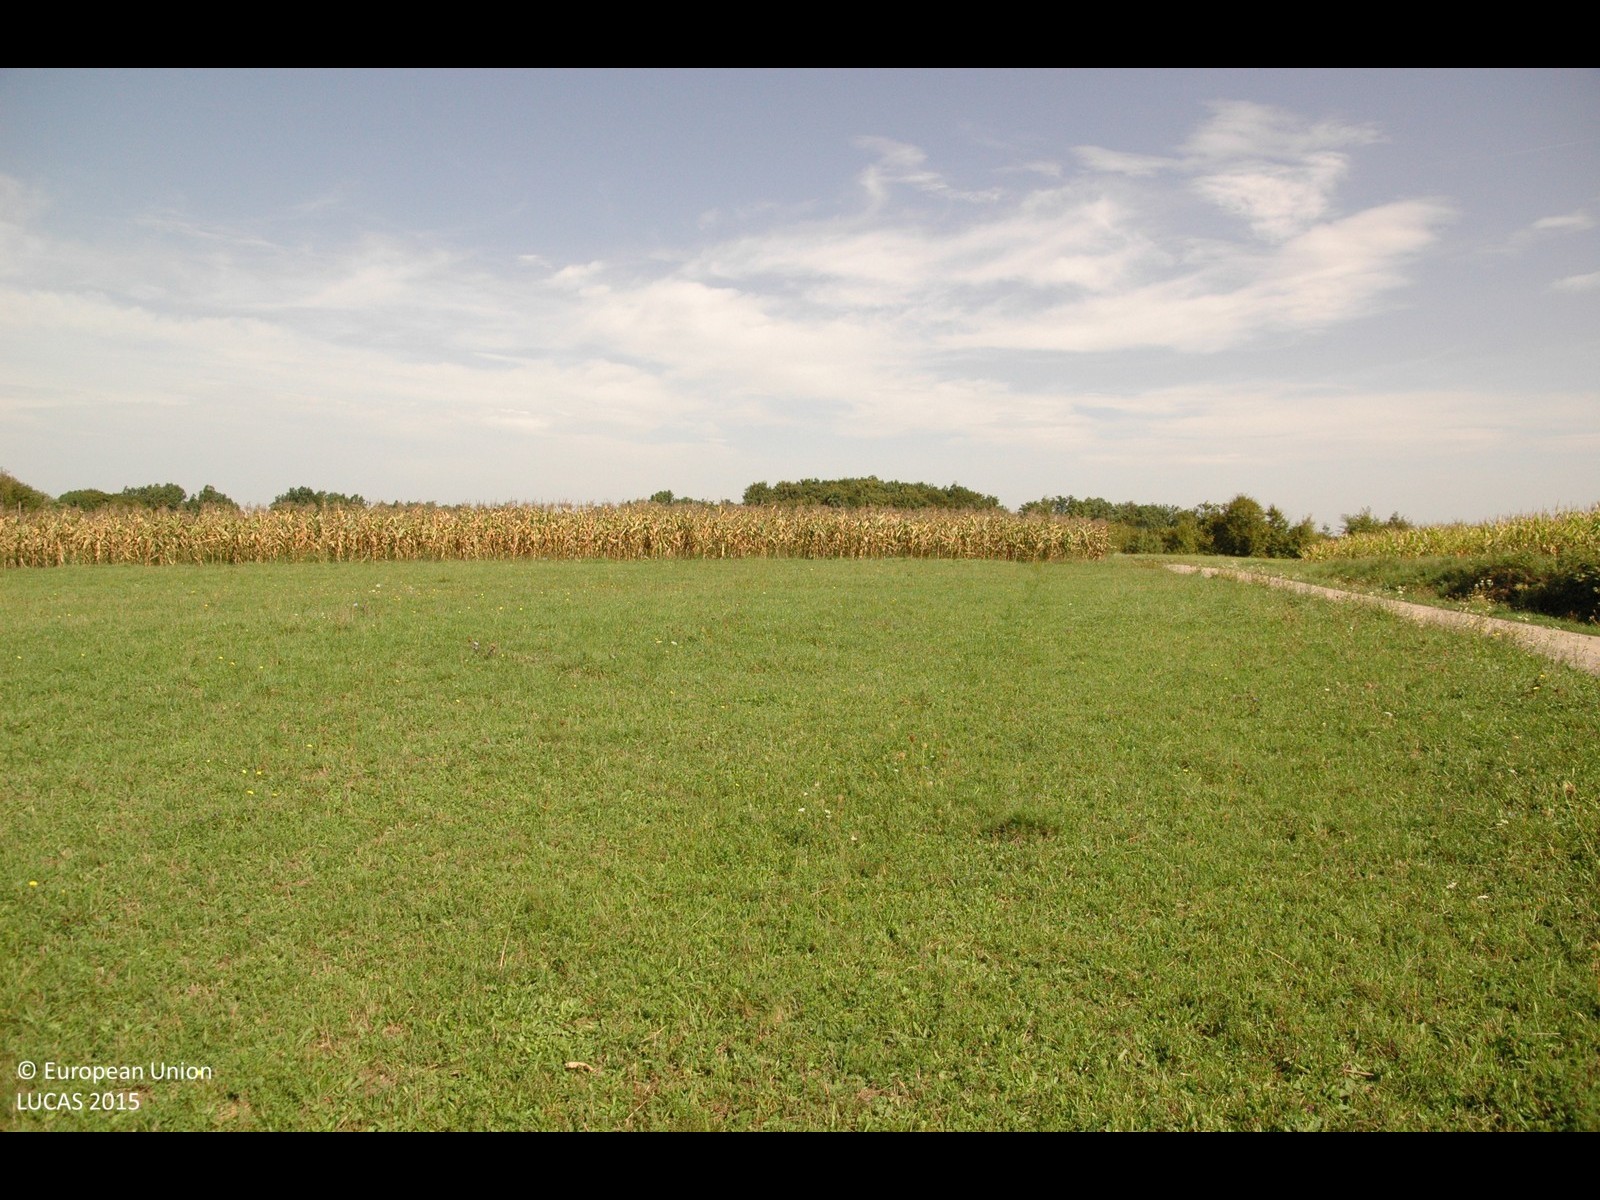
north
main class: Grassland
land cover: Grassland without tree/shrub cover
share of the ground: > 75 %
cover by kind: herbaceous plants 100 %
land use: Agriculture (excluding fallow land and kitchen gardens)
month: September
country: HR
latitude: 45.5560
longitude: 15.9026
